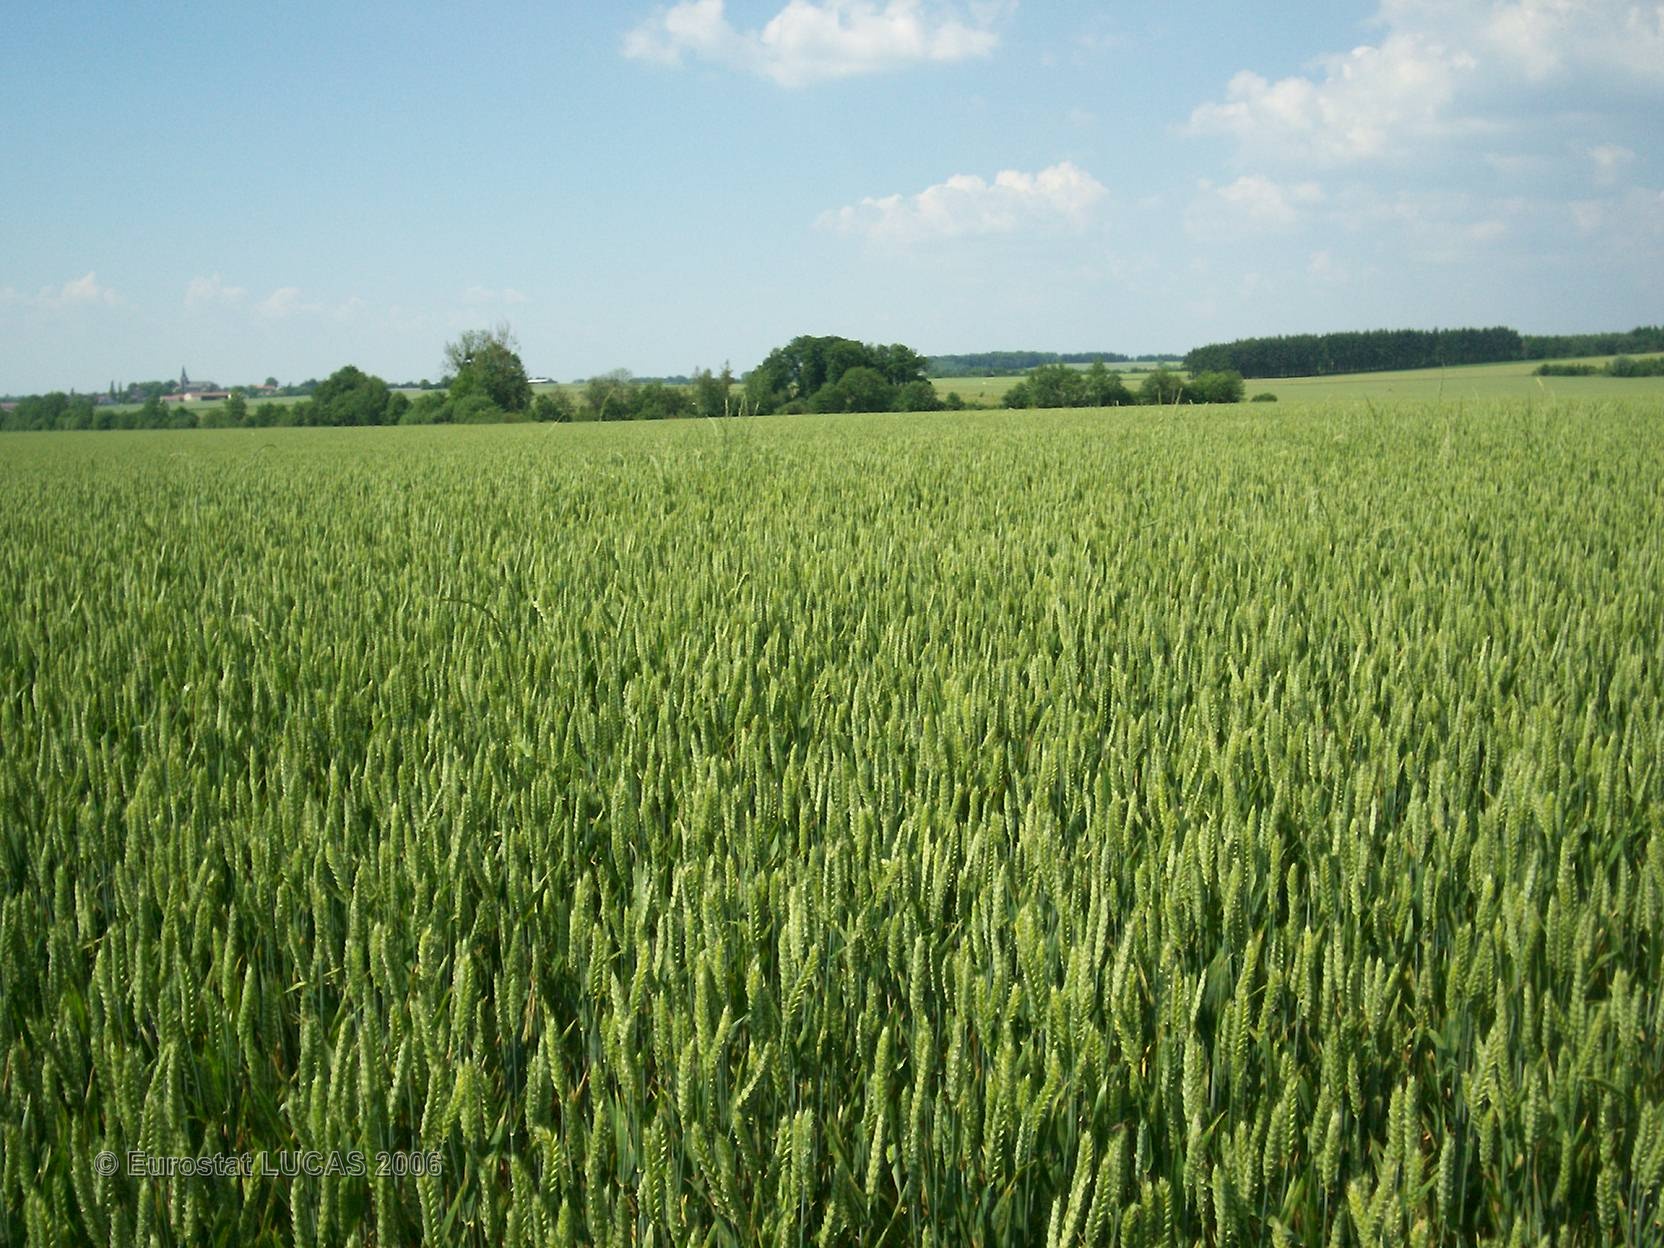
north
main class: Cropland
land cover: Common wheat
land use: Agriculture (excluding fallow land and kitchen gardens)
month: June
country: FR
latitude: 49.2029
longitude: 4.8506
